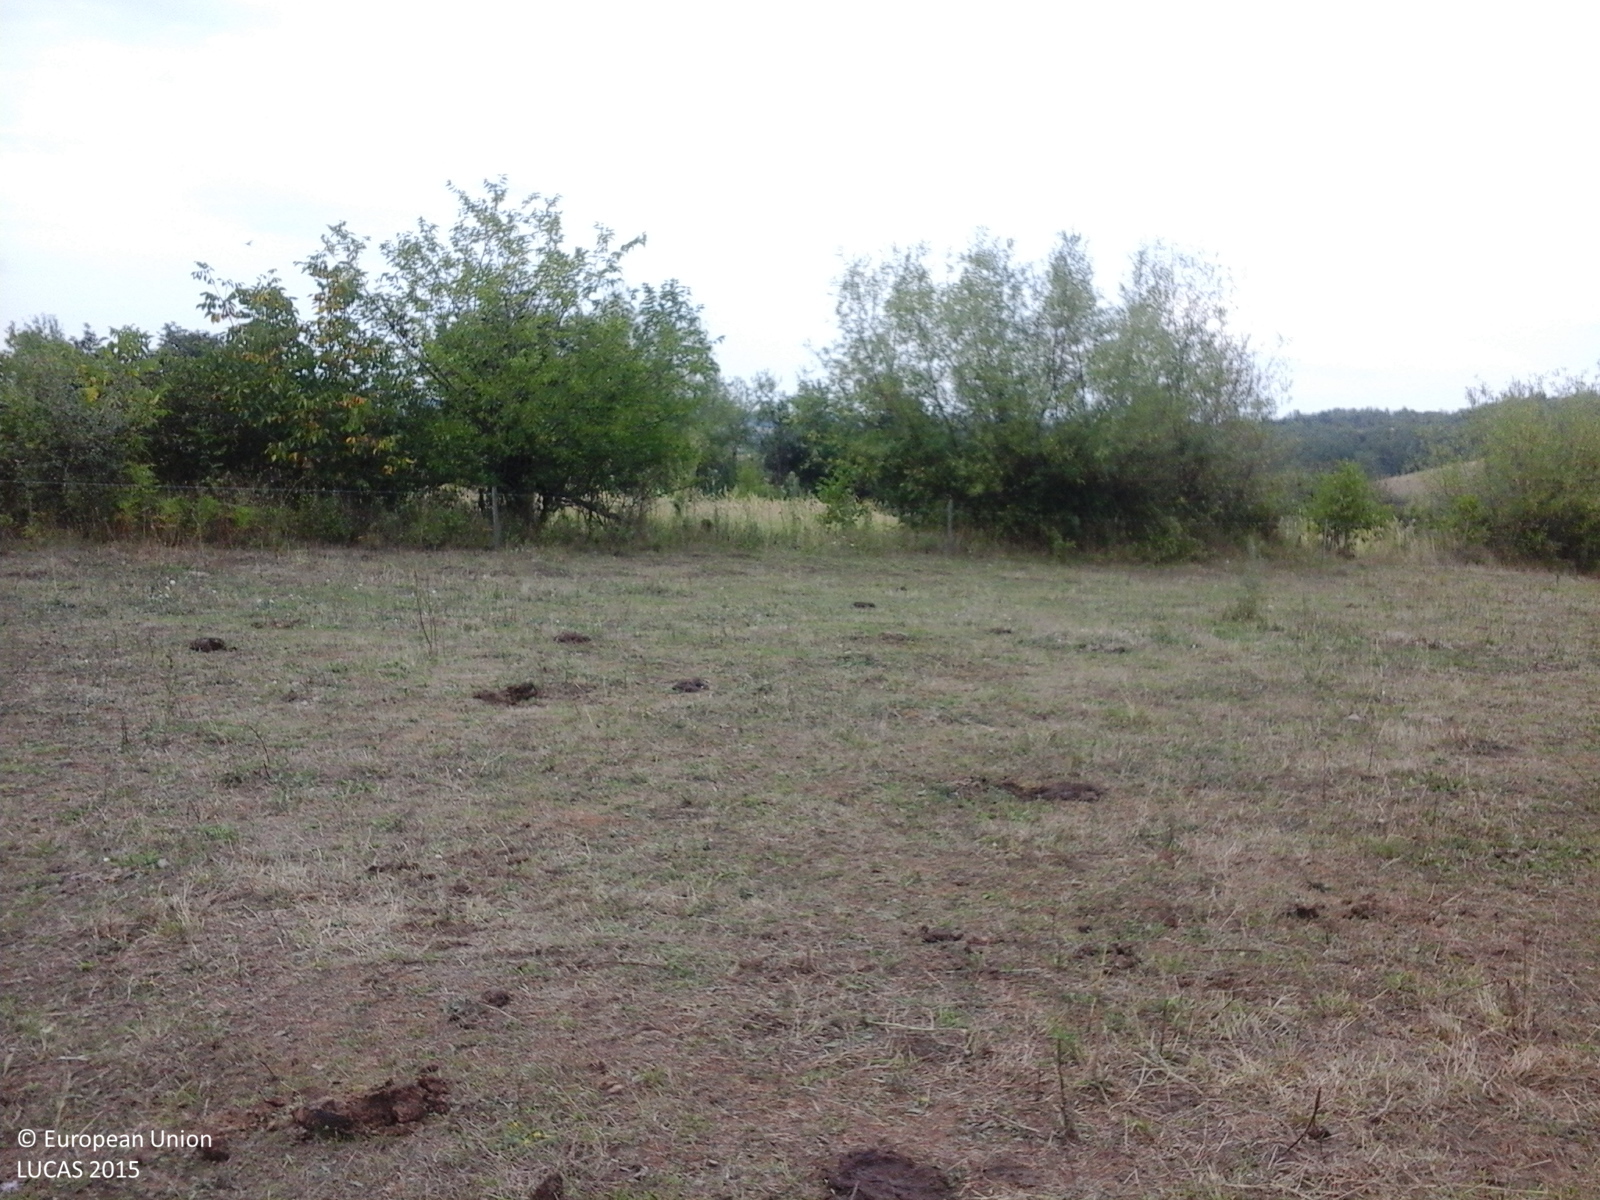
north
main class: Grassland
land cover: Grassland without tree/shrub cover
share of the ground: > 75 %
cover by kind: herbaceous plants 100 %
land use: Agriculture (excluding fallow land and kitchen gardens)
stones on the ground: < 10 %
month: August
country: RO
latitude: 45.4659
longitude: 21.7377
